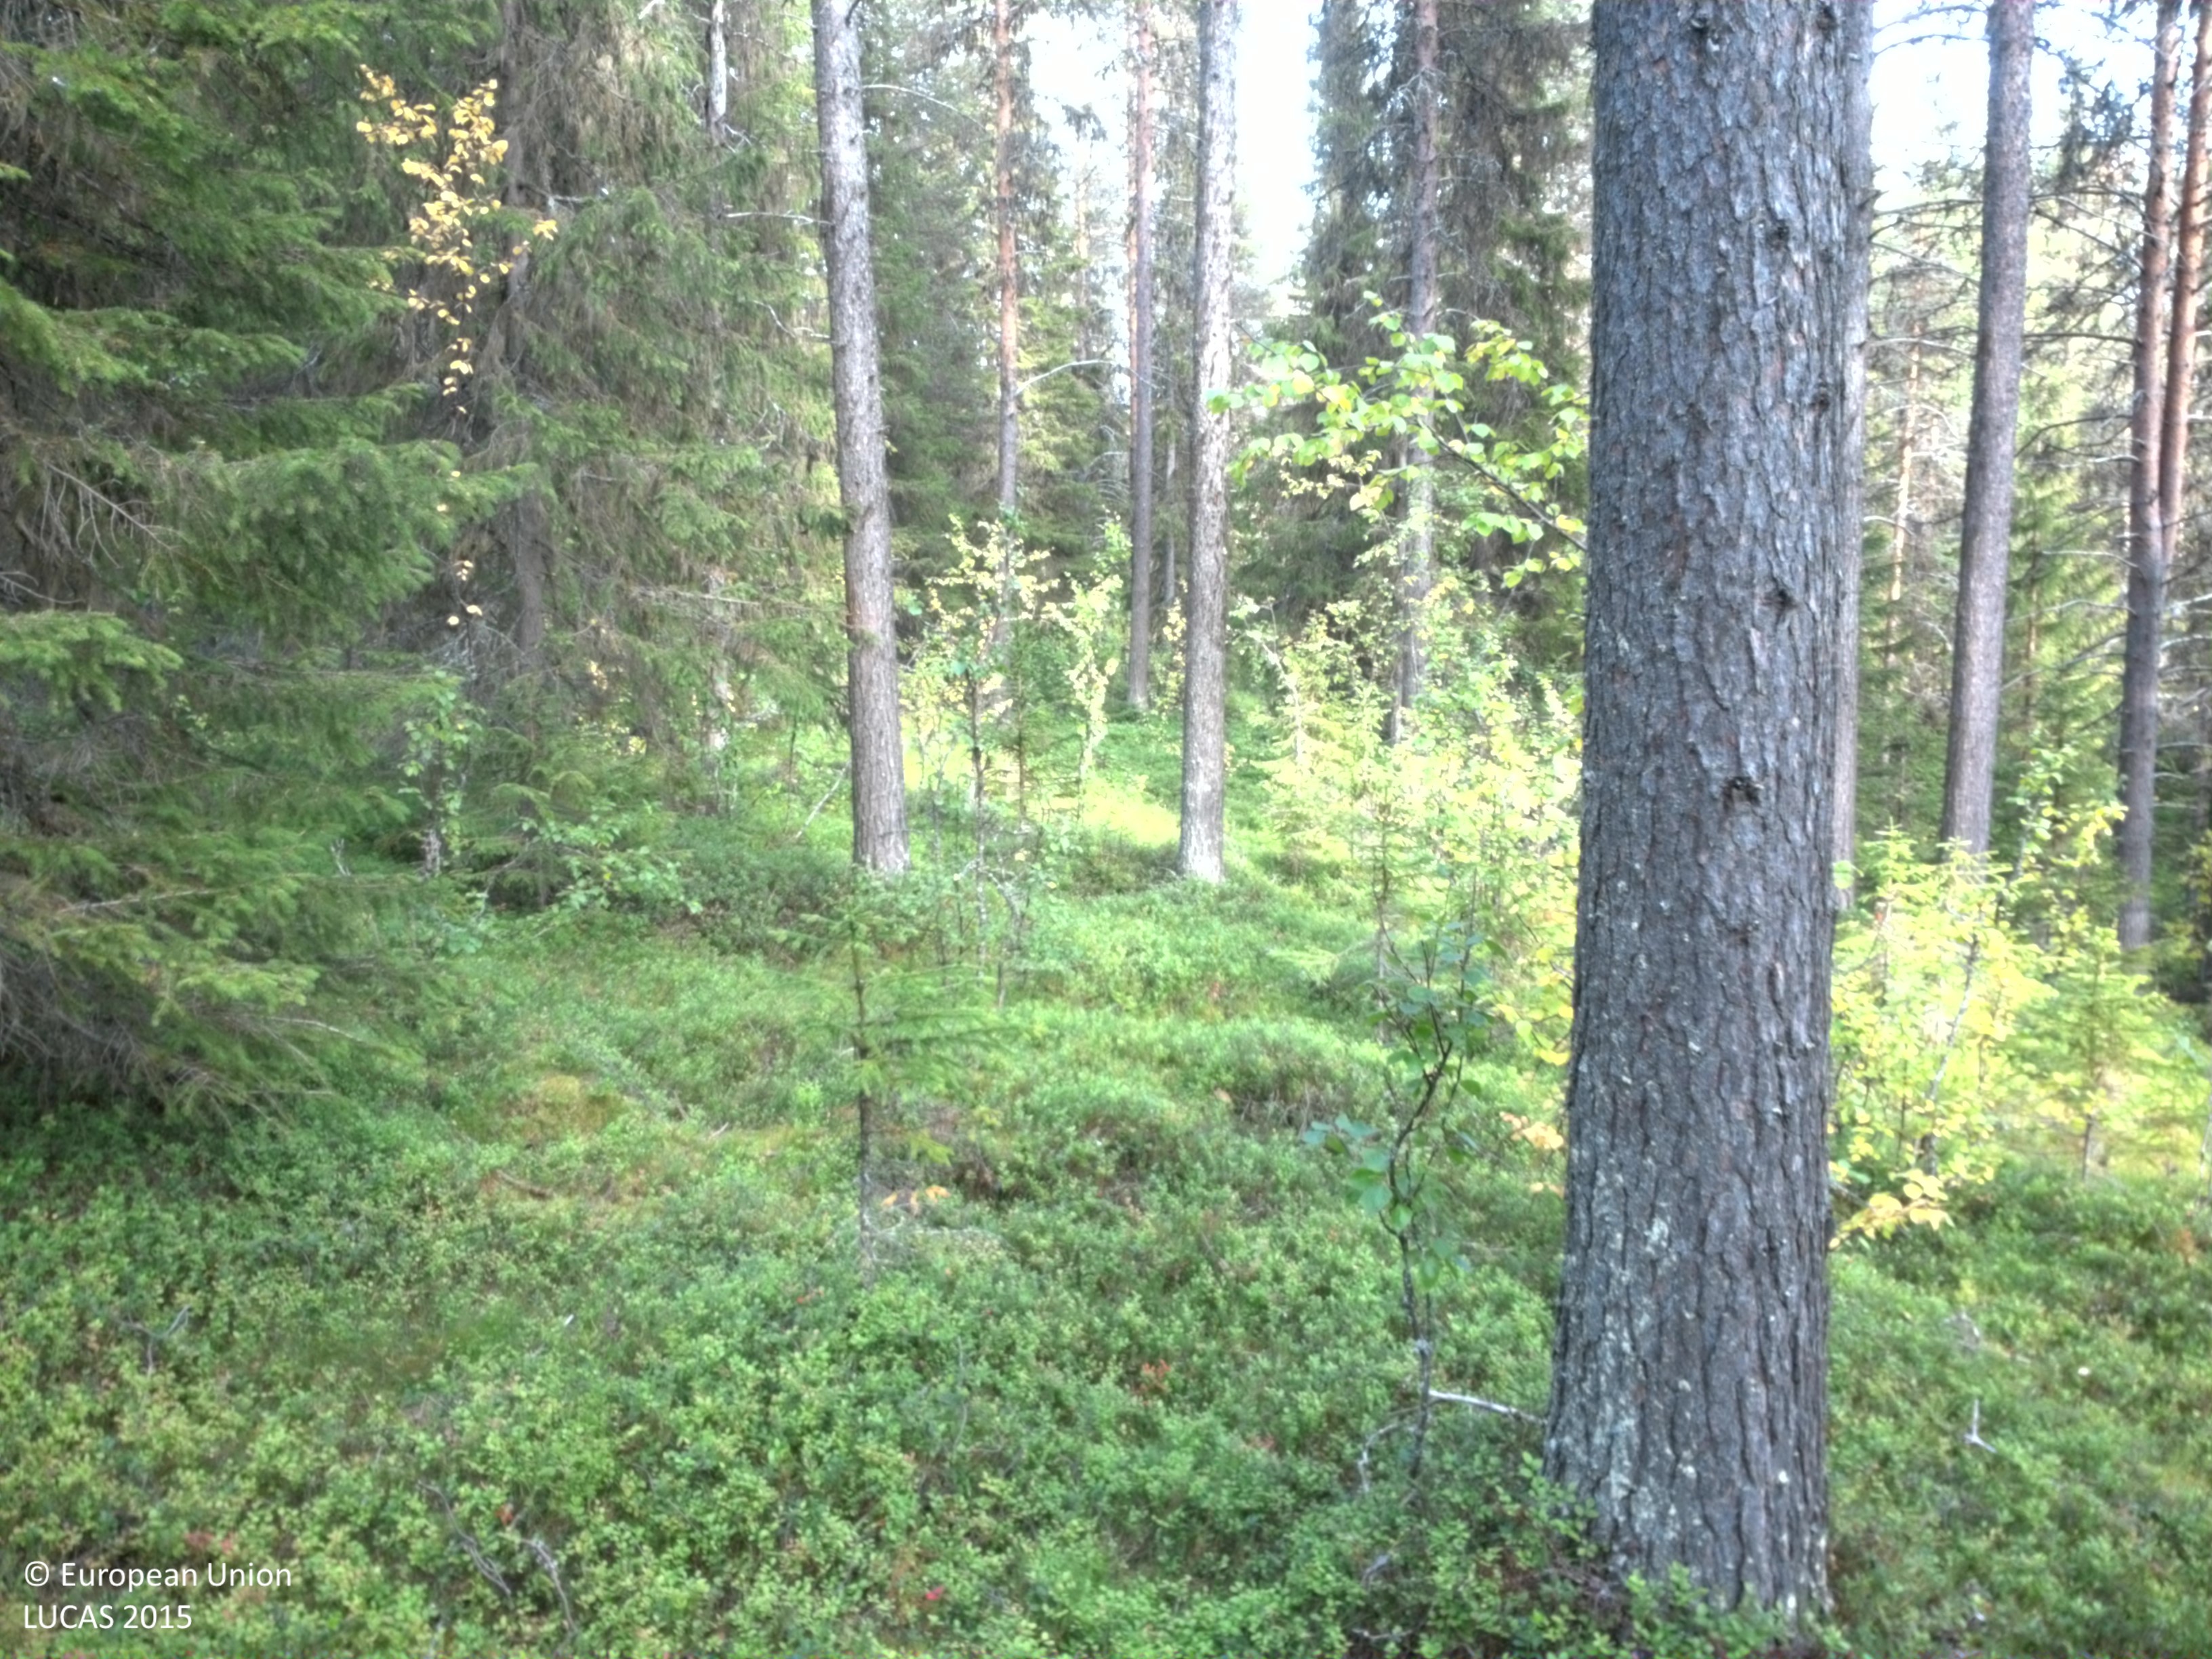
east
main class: Woodland
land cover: Other coniferous woodland
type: boreal forest
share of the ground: 25 - 50 %
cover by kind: coniferous forest trees 35 %, shrubs 35 %, lichens and mosses 20 %, broadleaved forest trees 5 %, herbaceous plants 5 %
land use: Forestry
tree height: > 5 m
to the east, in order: Other coniferous woodland; Other mixed woodland; Shrubland with sparse tree cover; Tracks; Shrubland with sparse tree cover; Other mixed woodland; Spruce dominated mixed woodland
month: September
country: SE
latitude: 65.3849
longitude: 16.6106
